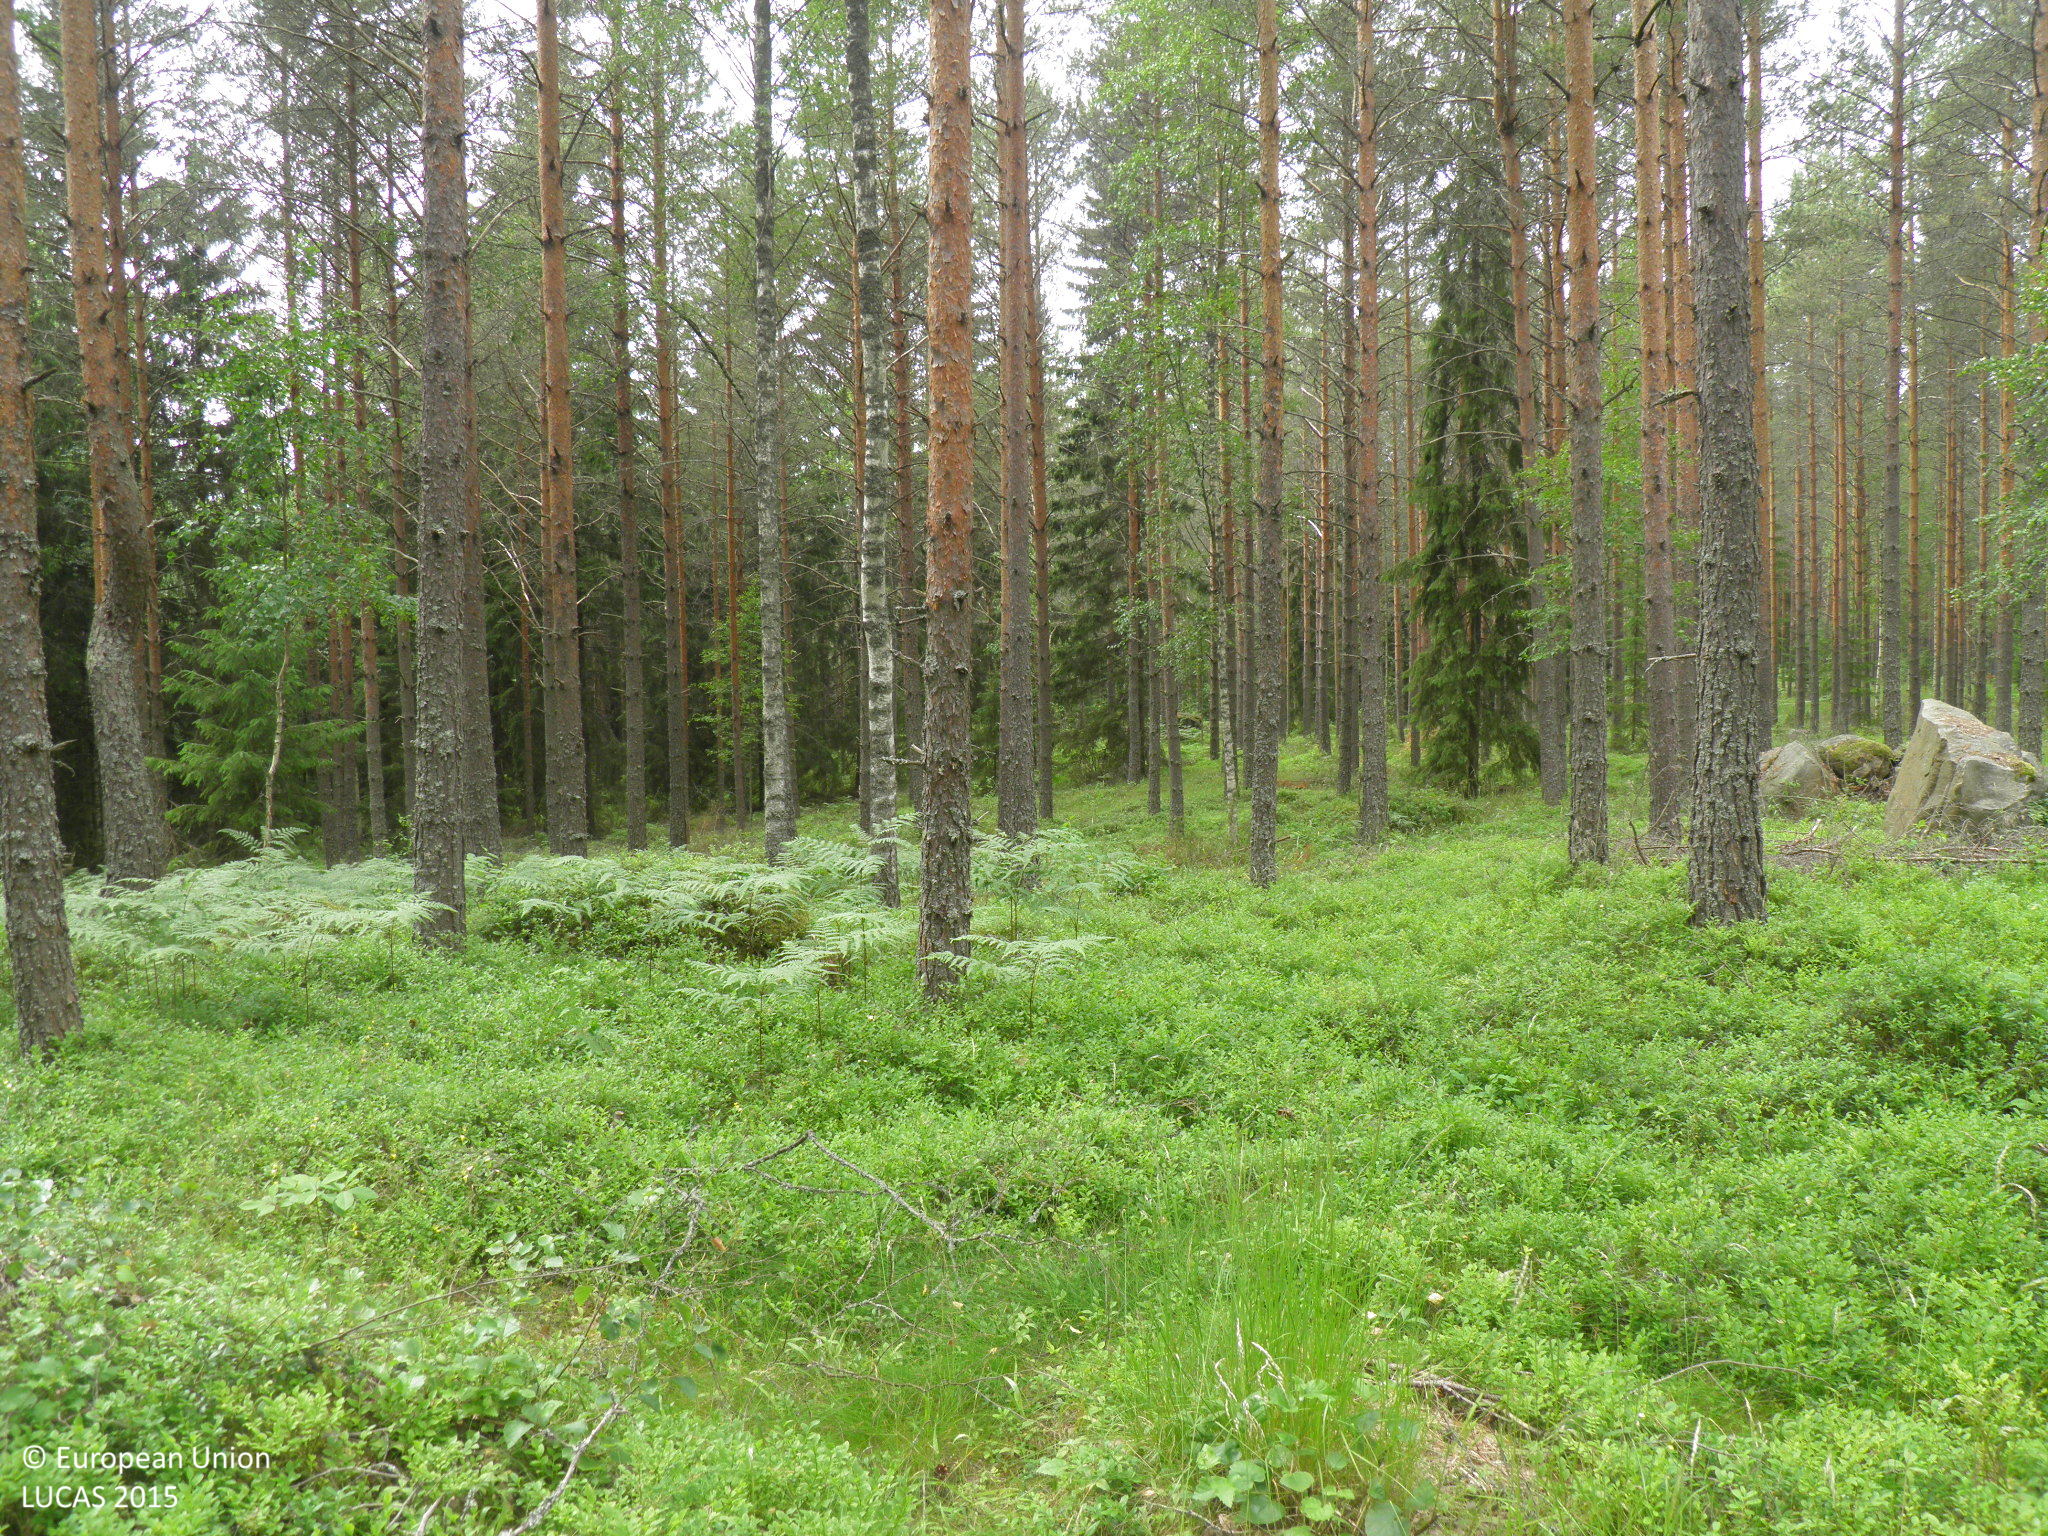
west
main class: Woodland
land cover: Pine dominated coniferous woodland
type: boreal forest
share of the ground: 50 - 75 %
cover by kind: coniferous forest trees 55 %, broadleaved forest trees 15 %, shrubs 15 %, herbaceous plants 15 %
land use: Forestry
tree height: > 5 m
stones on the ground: < 10 %
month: July
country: FI
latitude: 60.7215
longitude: 22.6644
